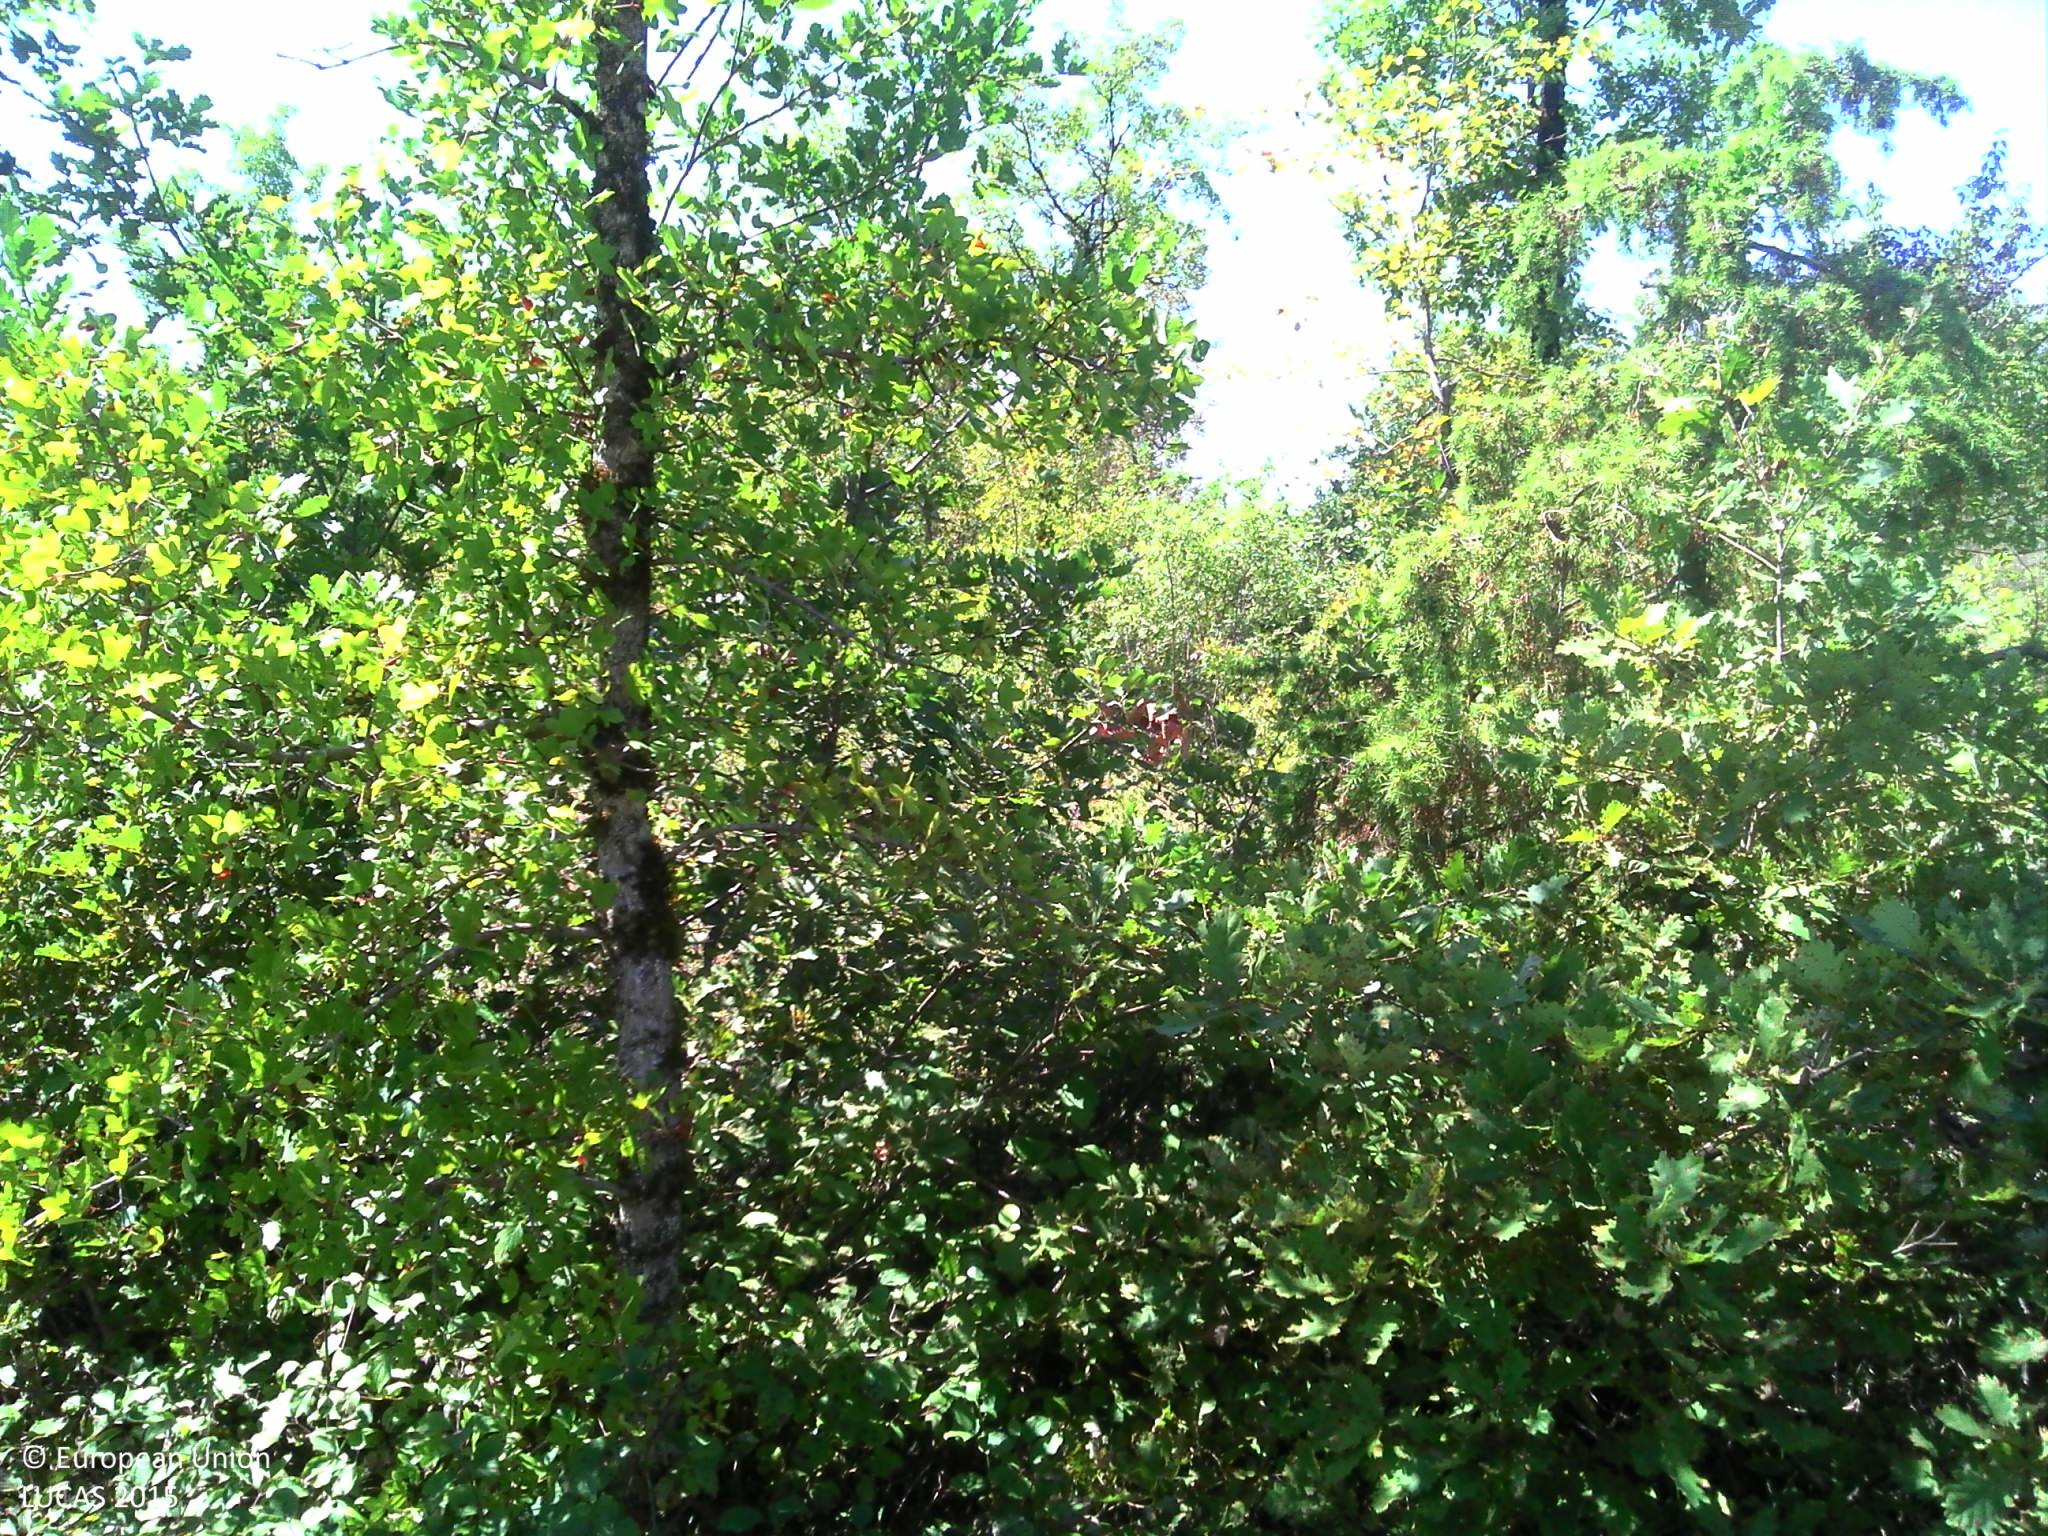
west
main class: Woodland
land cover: Broadleaved woodland
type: thermophilous deciduous forest
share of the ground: > 75 %
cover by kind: broadleaved forest trees 50 %, shrubs 30 %, herbaceous plants 20 %
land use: Semi-natural and natural areas not in use
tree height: > 5 m
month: August
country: FR
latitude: 44.4101
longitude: 1.6233
